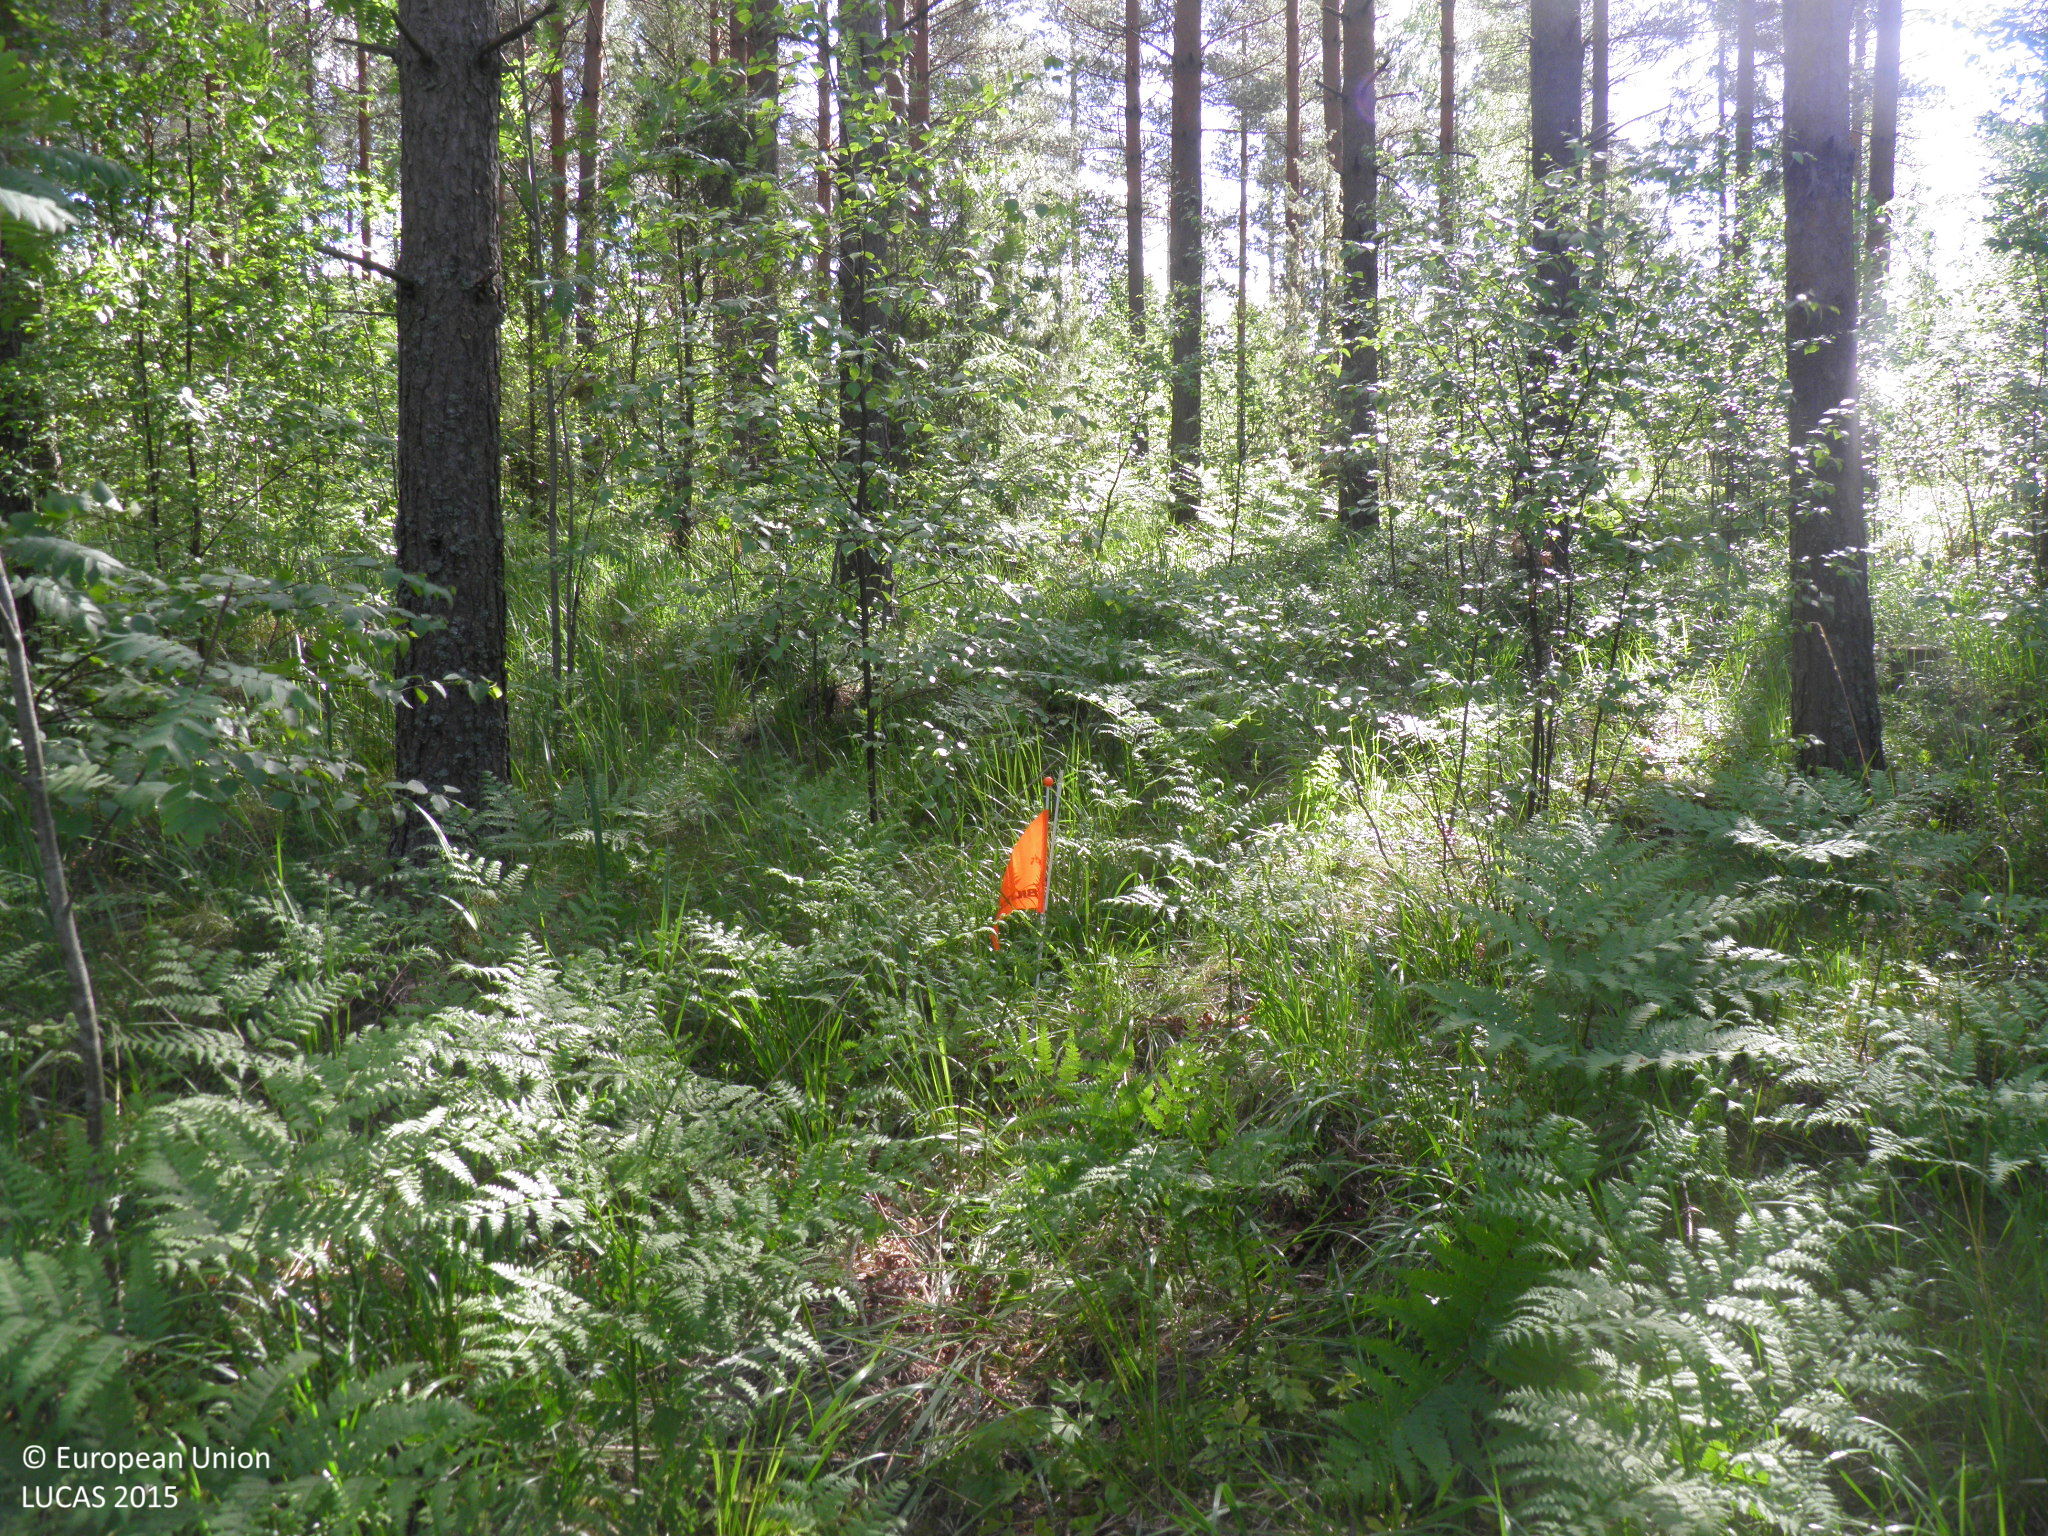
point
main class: Woodland
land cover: Pine dominated coniferous woodland
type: boreal forest
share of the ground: > 75 %
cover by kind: coniferous forest trees 70 %, broadleaved forest trees 10 %, herbaceous plants 10 %, lichens and mosses 10 %
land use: Forestry
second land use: Amenities, museums, leisure
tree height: > 5 m
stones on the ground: 25 - 50 %
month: June
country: FI
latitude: 60.4260
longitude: 22.6978
